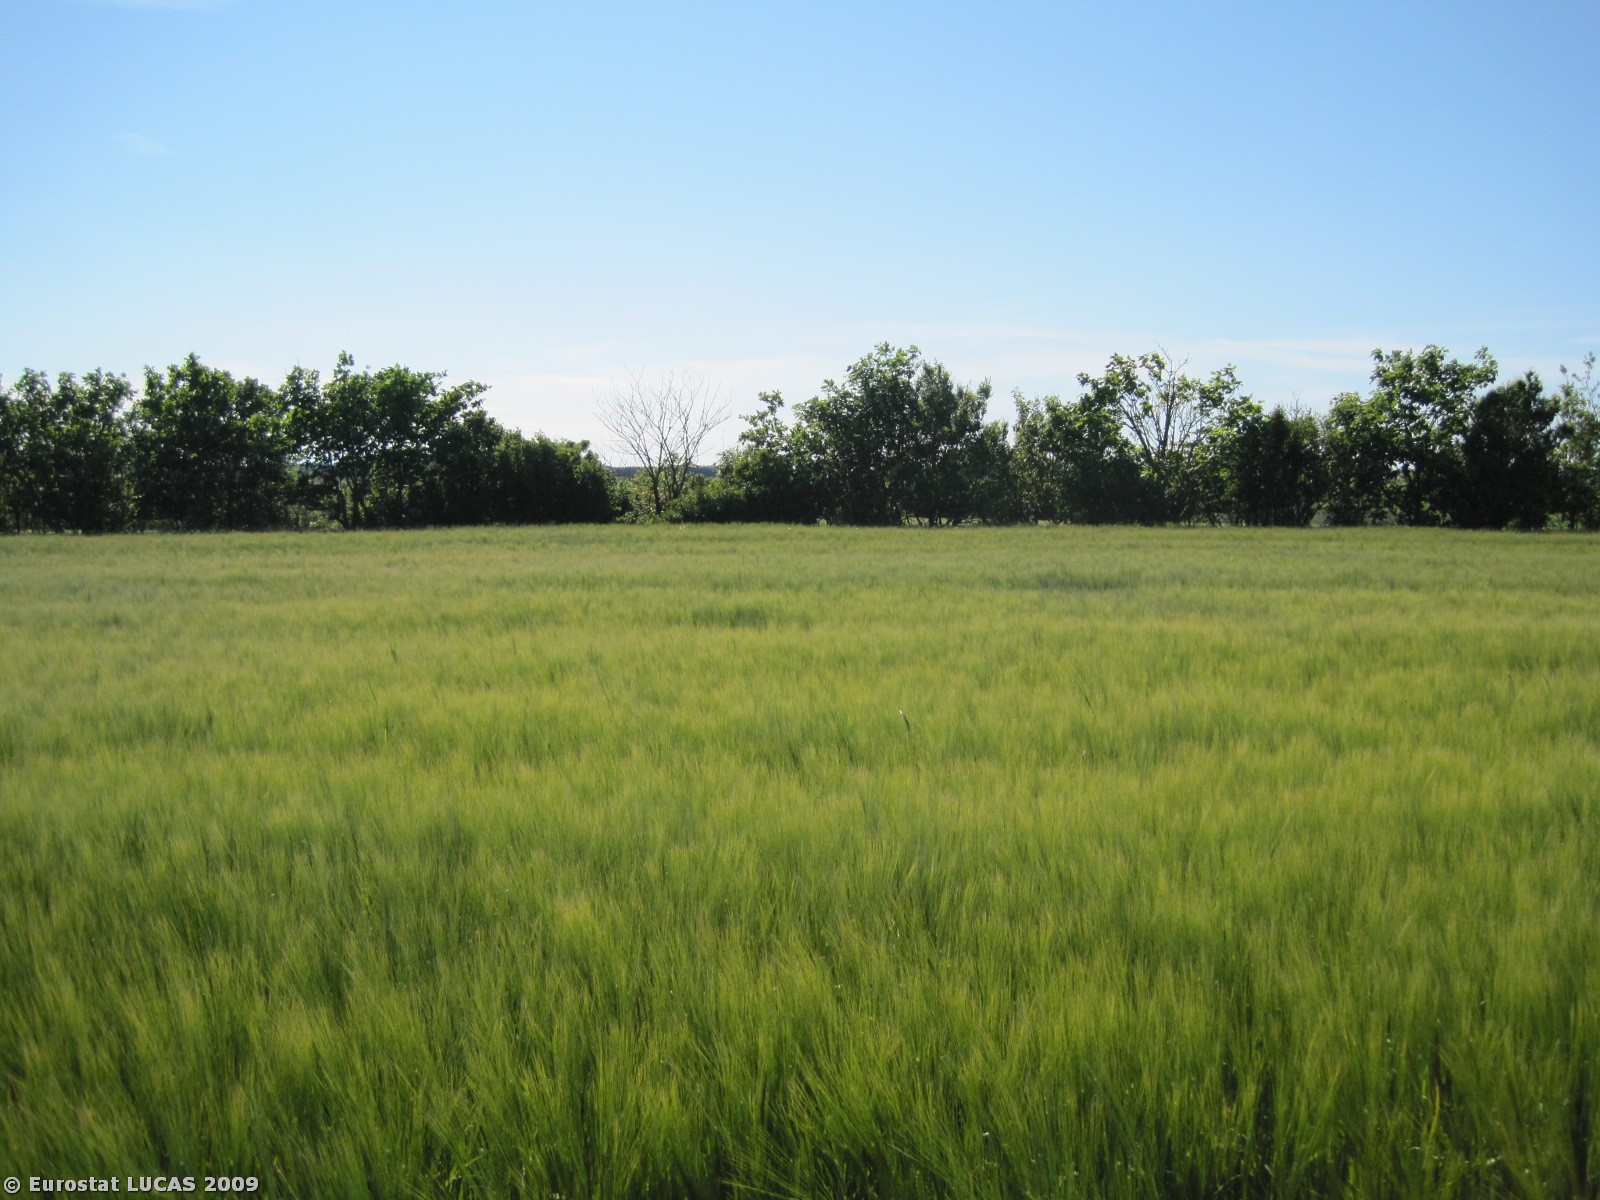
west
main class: Cropland
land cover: Barley
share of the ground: > 75 %
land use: Agriculture (excluding fallow land and kitchen gardens)
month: June
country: DK
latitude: 57.5181
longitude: 10.0167
